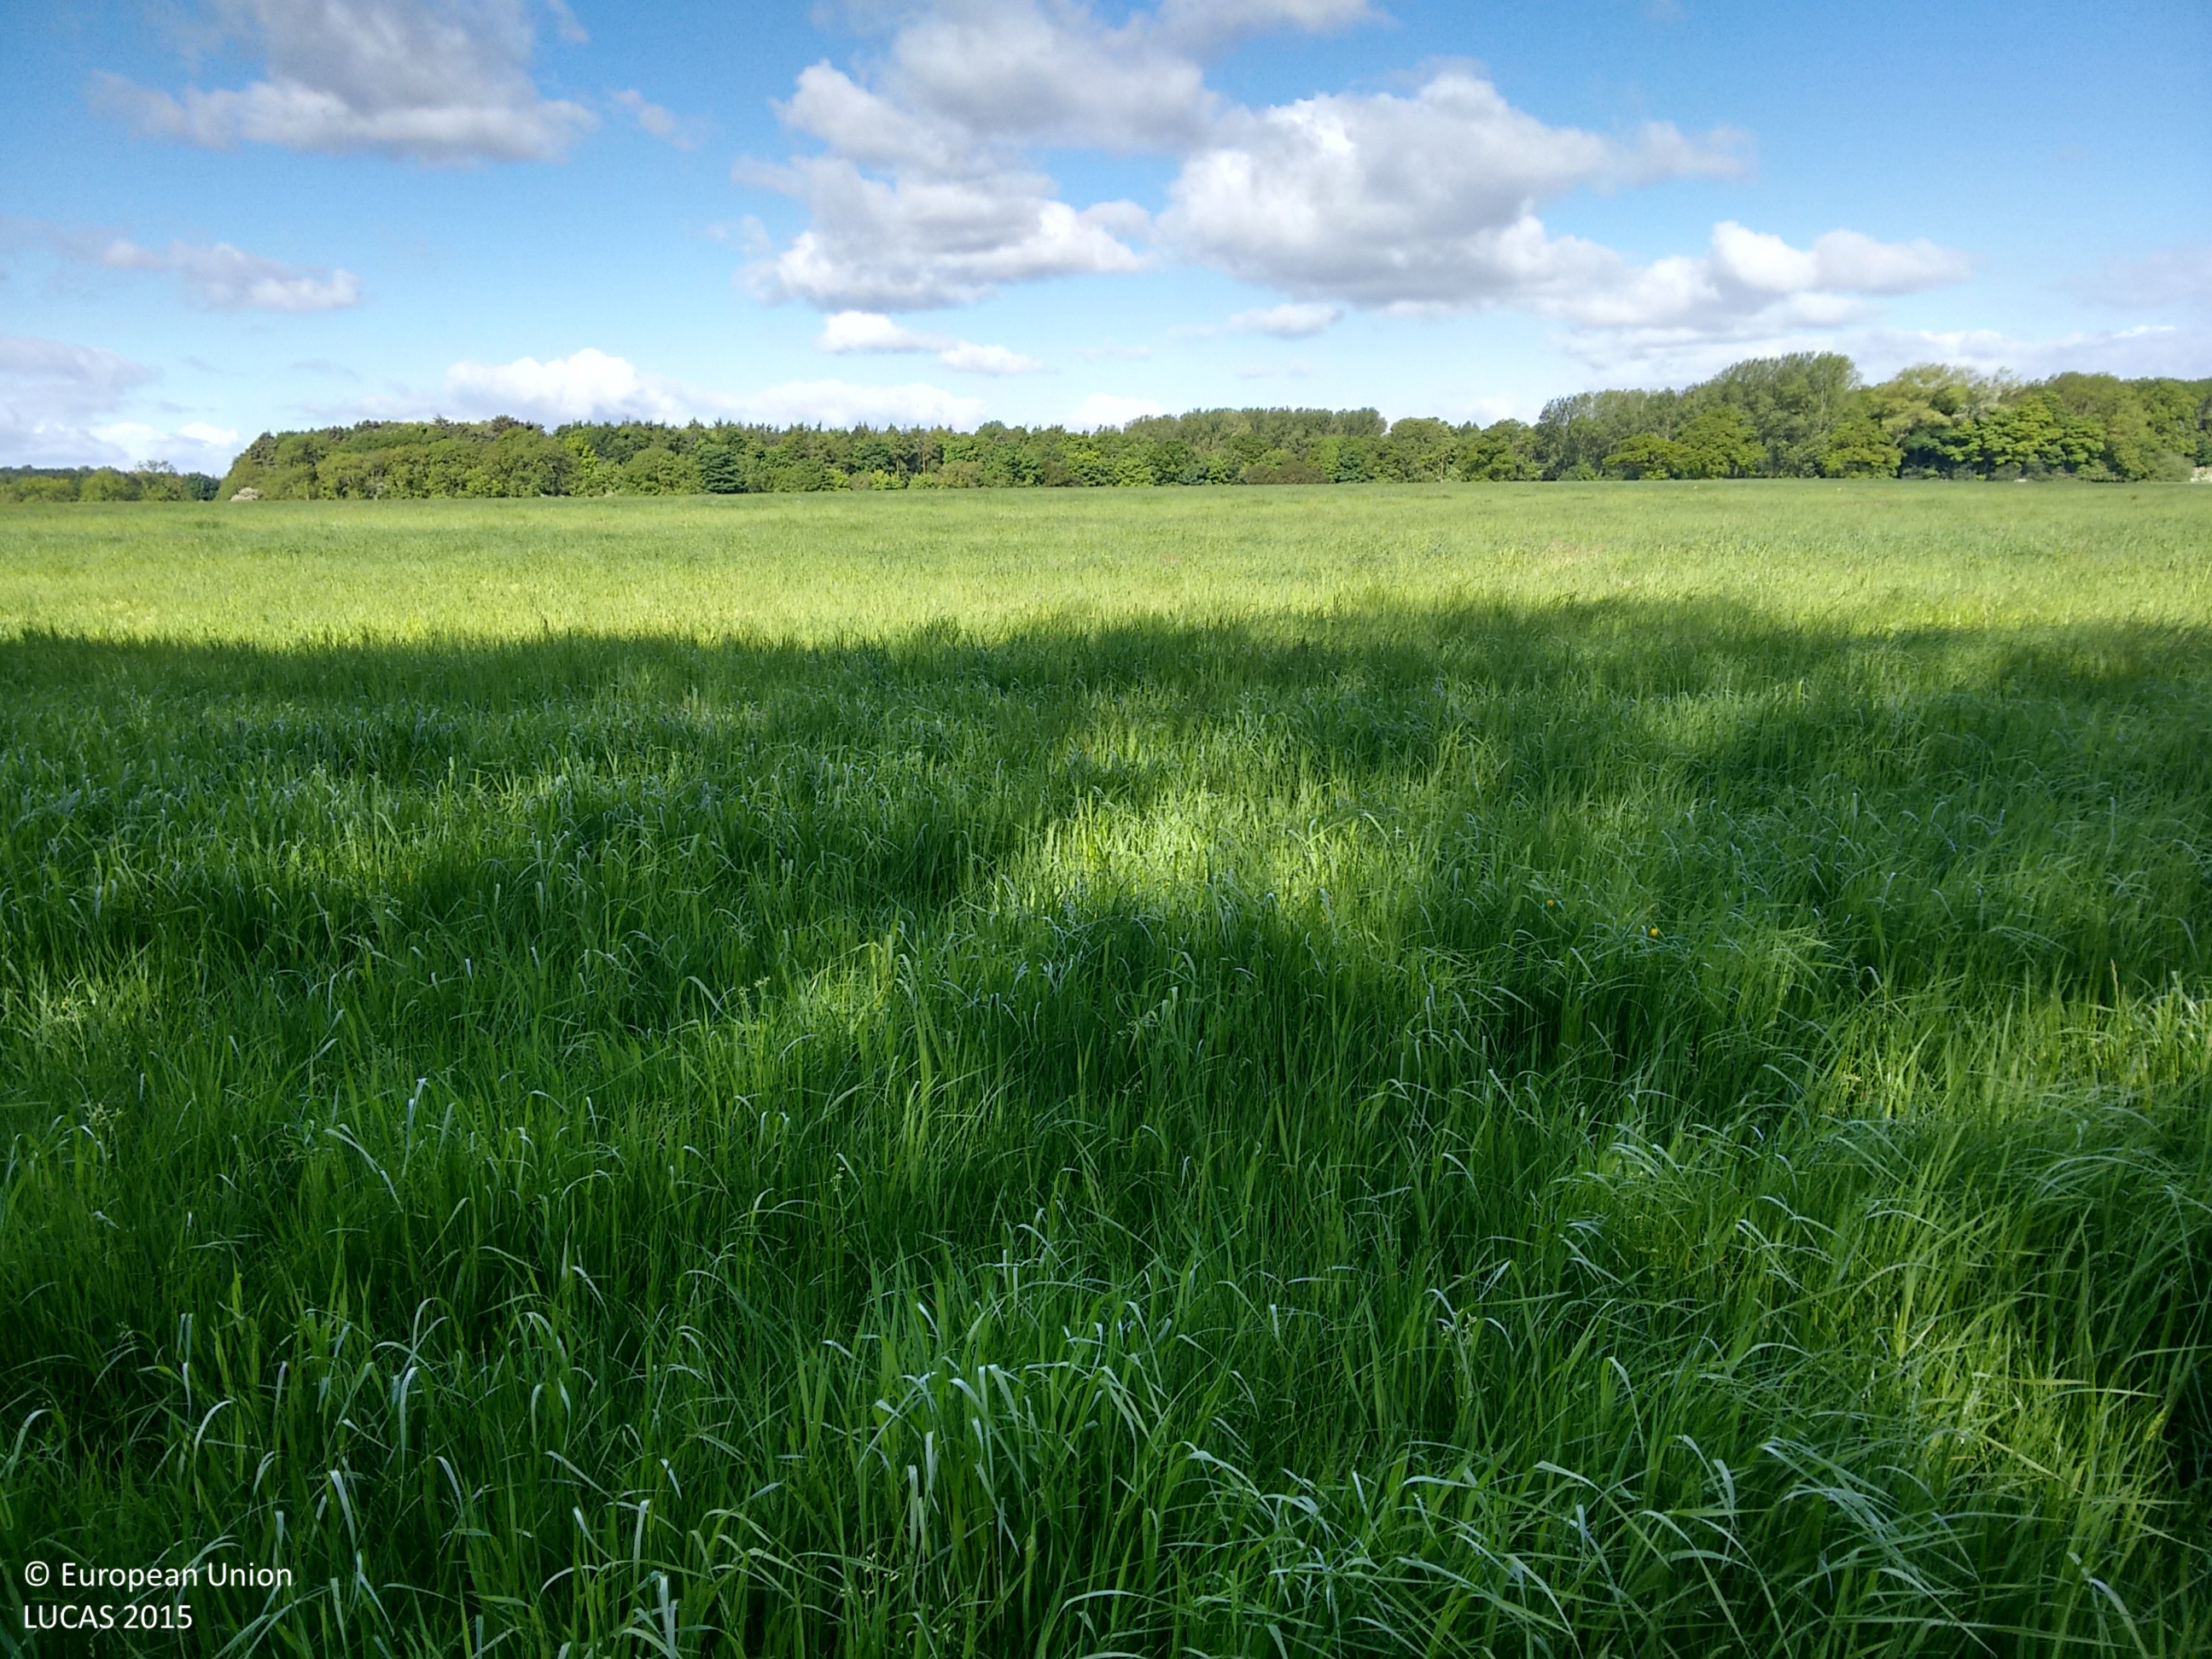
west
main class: Grassland
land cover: Grassland without tree/shrub cover
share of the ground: > 75 %
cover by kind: herbaceous plants 100 %
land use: Agriculture (excluding fallow land and kitchen gardens)
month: May
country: GB
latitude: 53.5966
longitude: -0.2943
